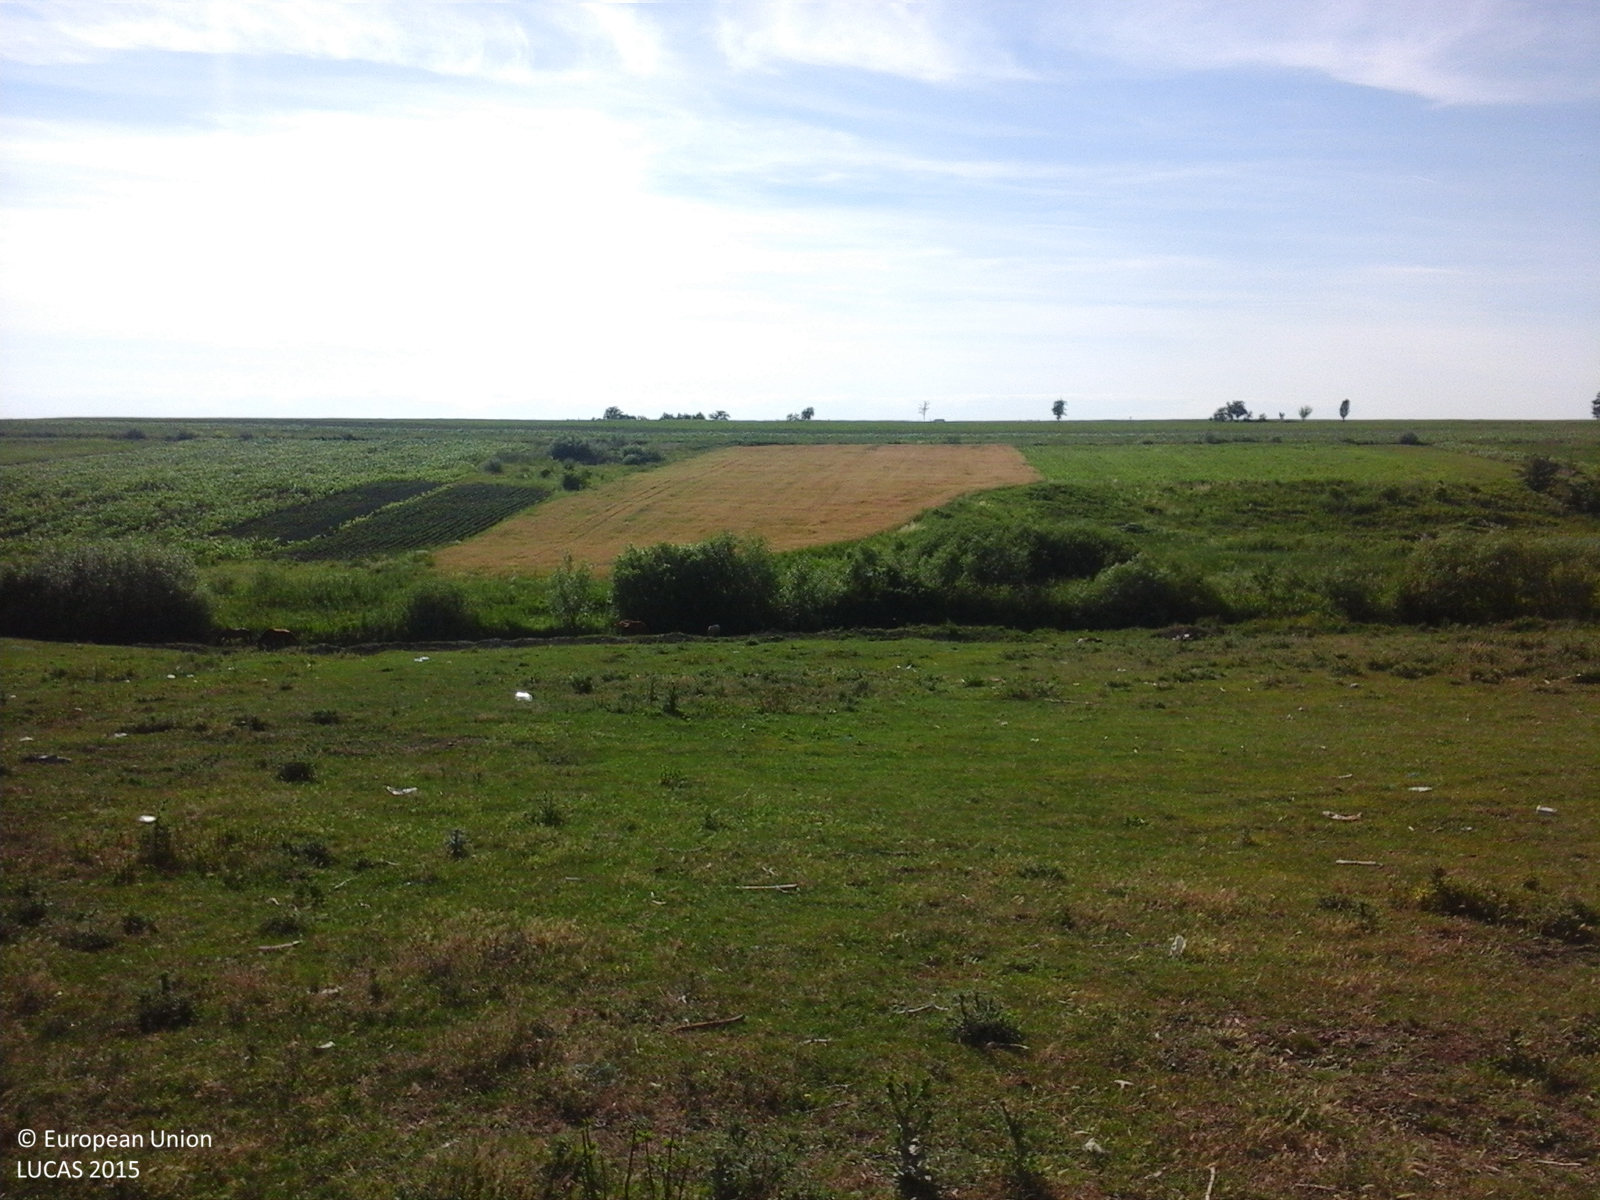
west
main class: Grassland
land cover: Grassland without tree/shrub cover
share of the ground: > 75 %
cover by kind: herbaceous plants 100 %
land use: Agriculture (excluding fallow land and kitchen gardens)
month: June
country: RO
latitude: 47.0868
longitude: 26.9191
